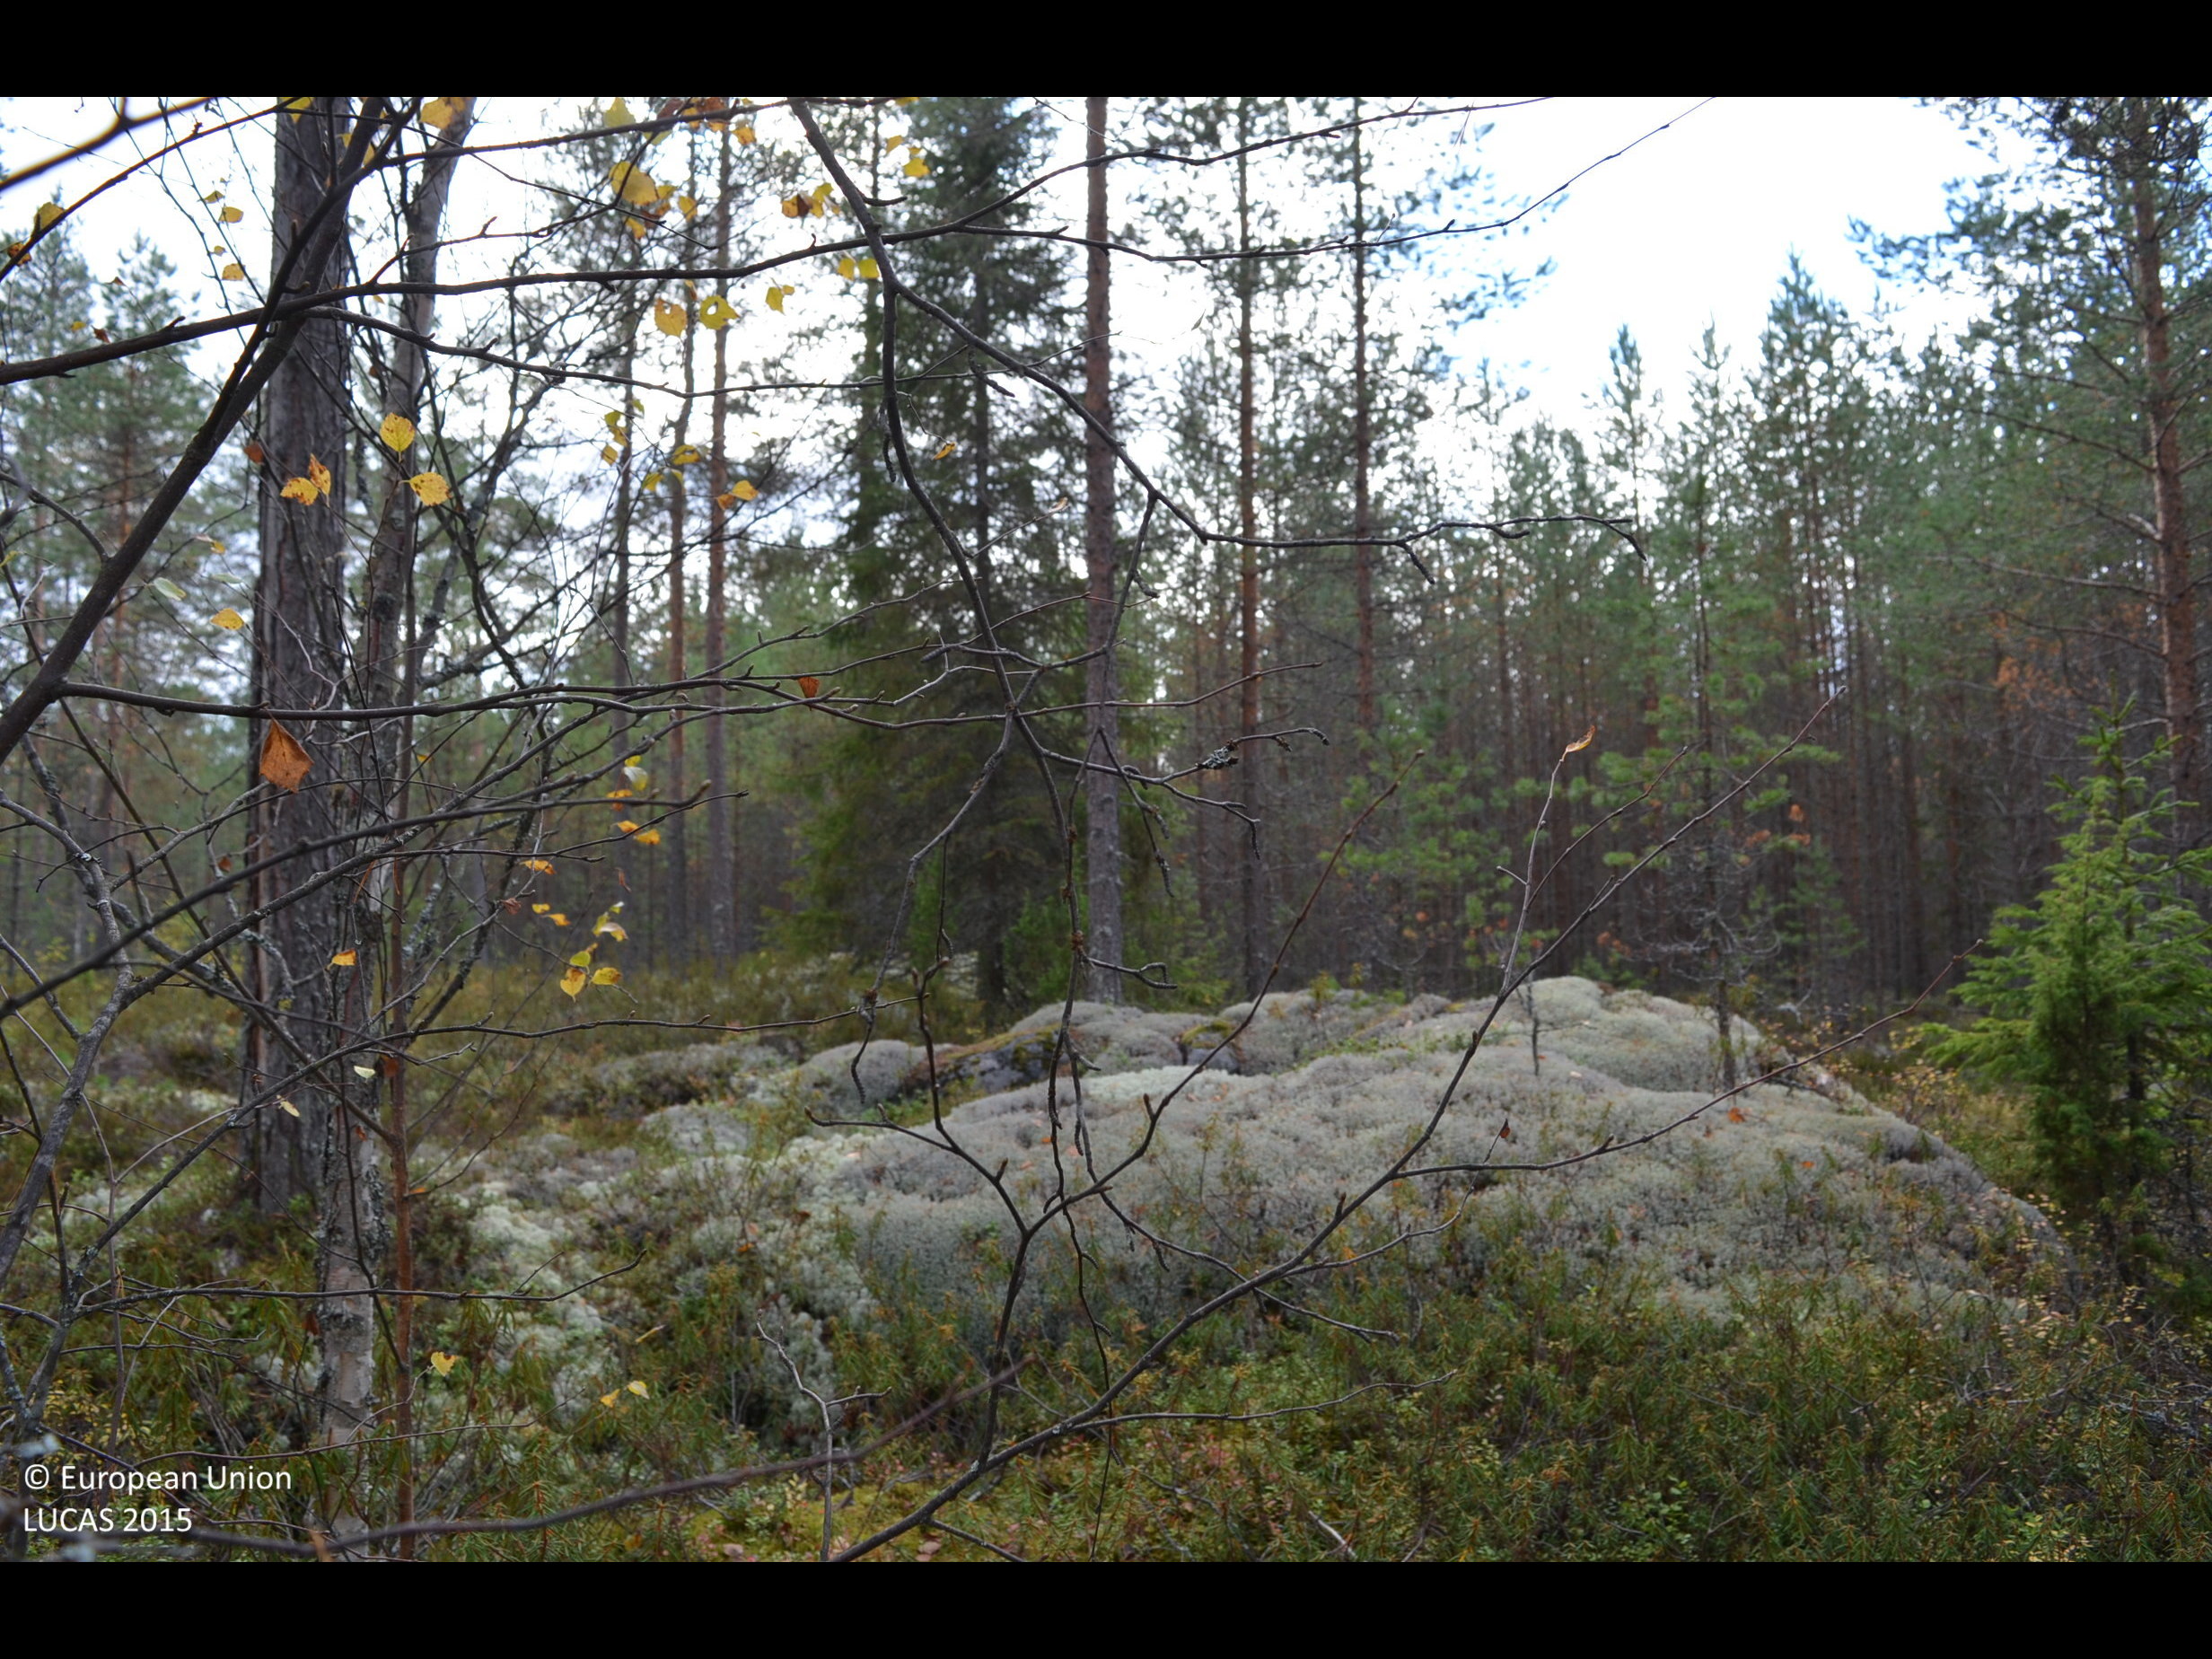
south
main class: Woodland
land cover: Pine dominated coniferous woodland
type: boreal forest
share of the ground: 50 - 75 %
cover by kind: coniferous forest trees 55 %, shrubs 25 %, unconsolidated bare surface 15 %, broadleaved forest trees 5 %
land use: Forestry
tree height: > 5 m
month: September
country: FI
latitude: 62.5259
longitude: 23.5756
